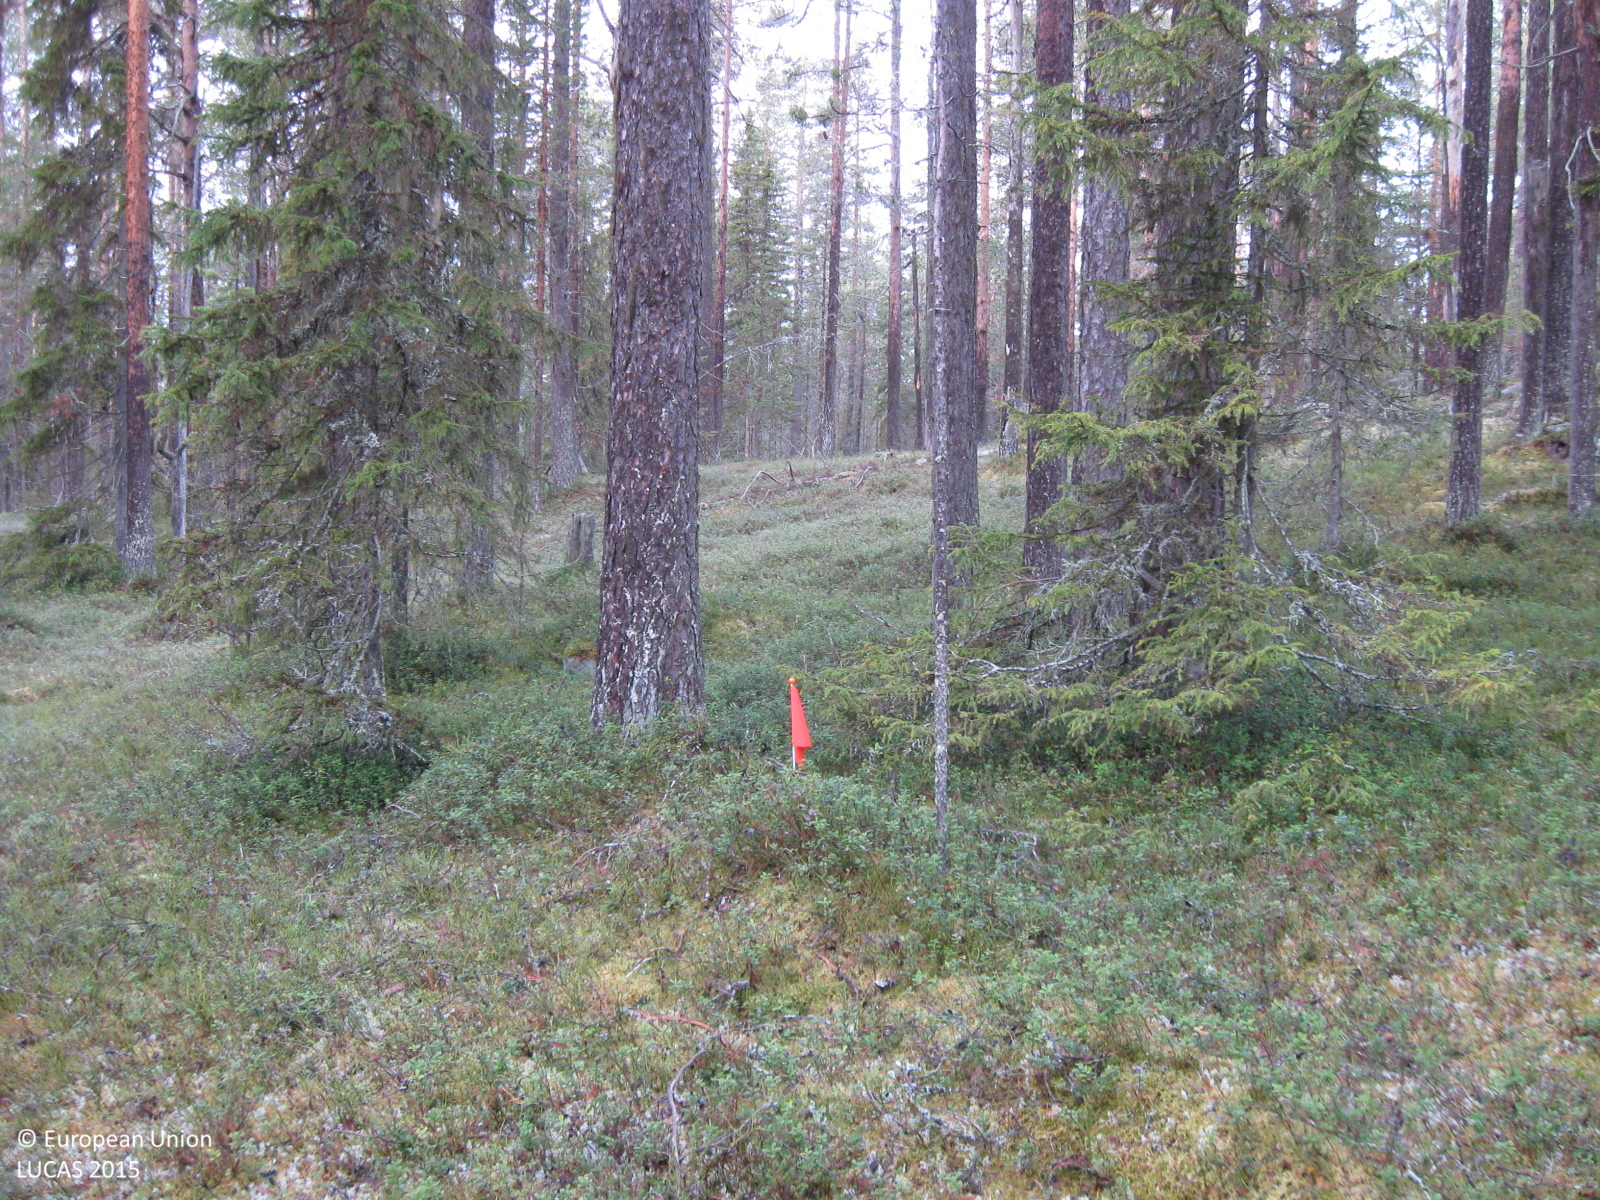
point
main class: Woodland
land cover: Pine dominated coniferous woodland
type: boreal forest
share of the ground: 50 - 75 %
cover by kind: coniferous forest trees 70 %, shrubs 15 %, lichens and mosses 10 %, herbaceous plants 5 %
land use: Forestry
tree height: > 5 m
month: October
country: SE
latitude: 66.4134
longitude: 20.9564
